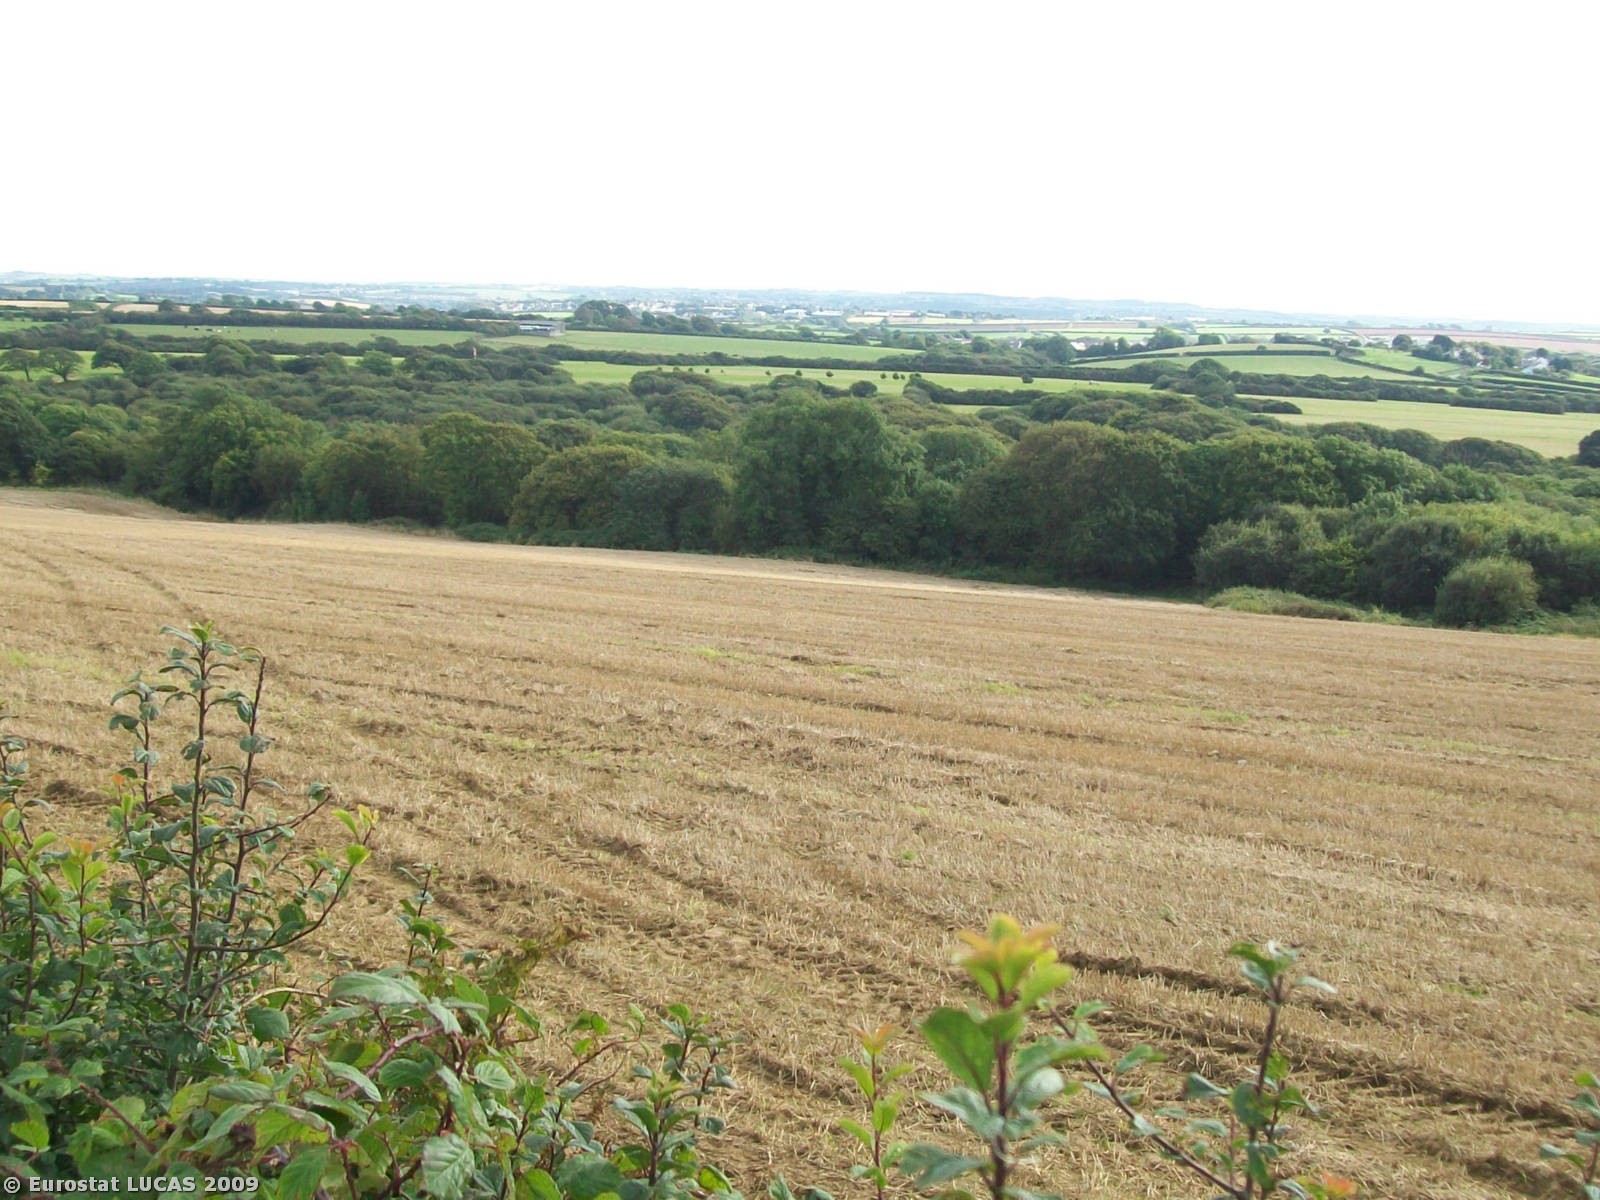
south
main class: Cropland
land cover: Common wheat
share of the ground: 10 - 25 %
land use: Agriculture (excluding fallow land and kitchen gardens)
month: September
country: GB
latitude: 51.7509
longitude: -4.9637
